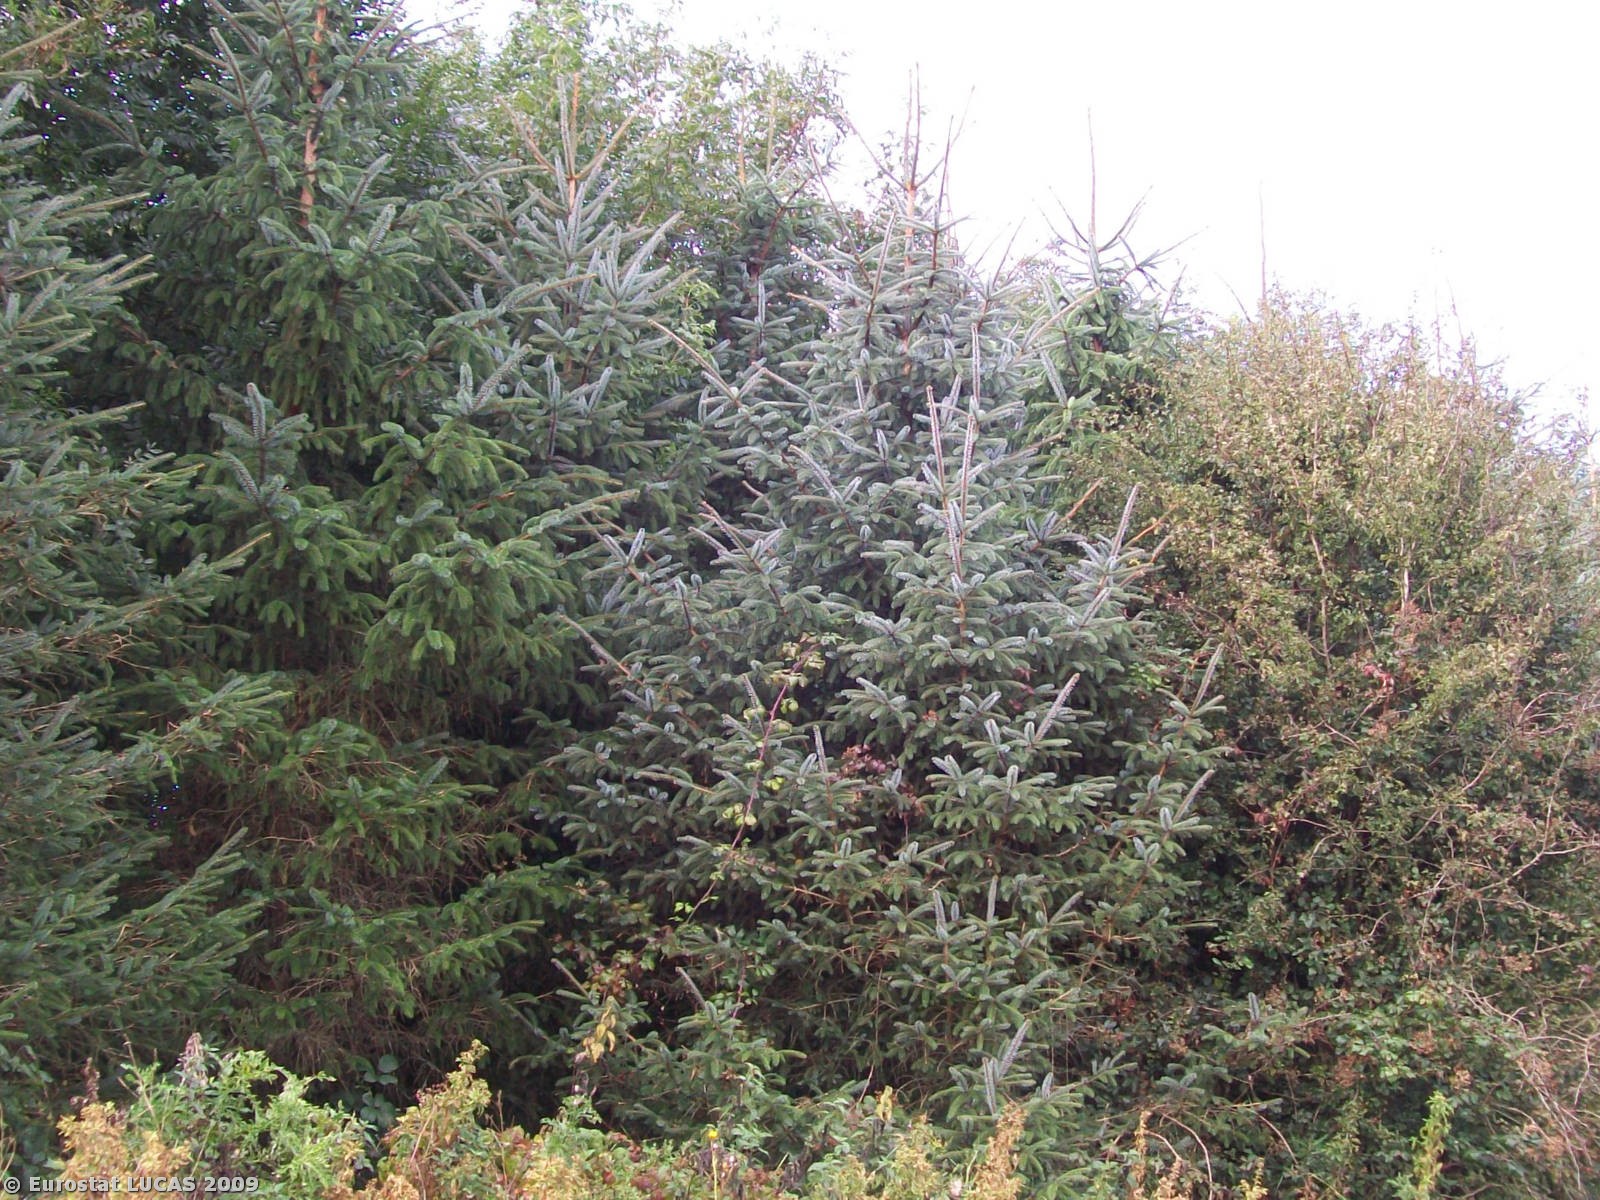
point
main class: Woodland
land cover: Coniferous woodland
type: plantations and self-sown exotic forest
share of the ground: > 75 %
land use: Forestry
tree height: > 5 m
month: September
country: IE
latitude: 53.1507
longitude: -7.9527
